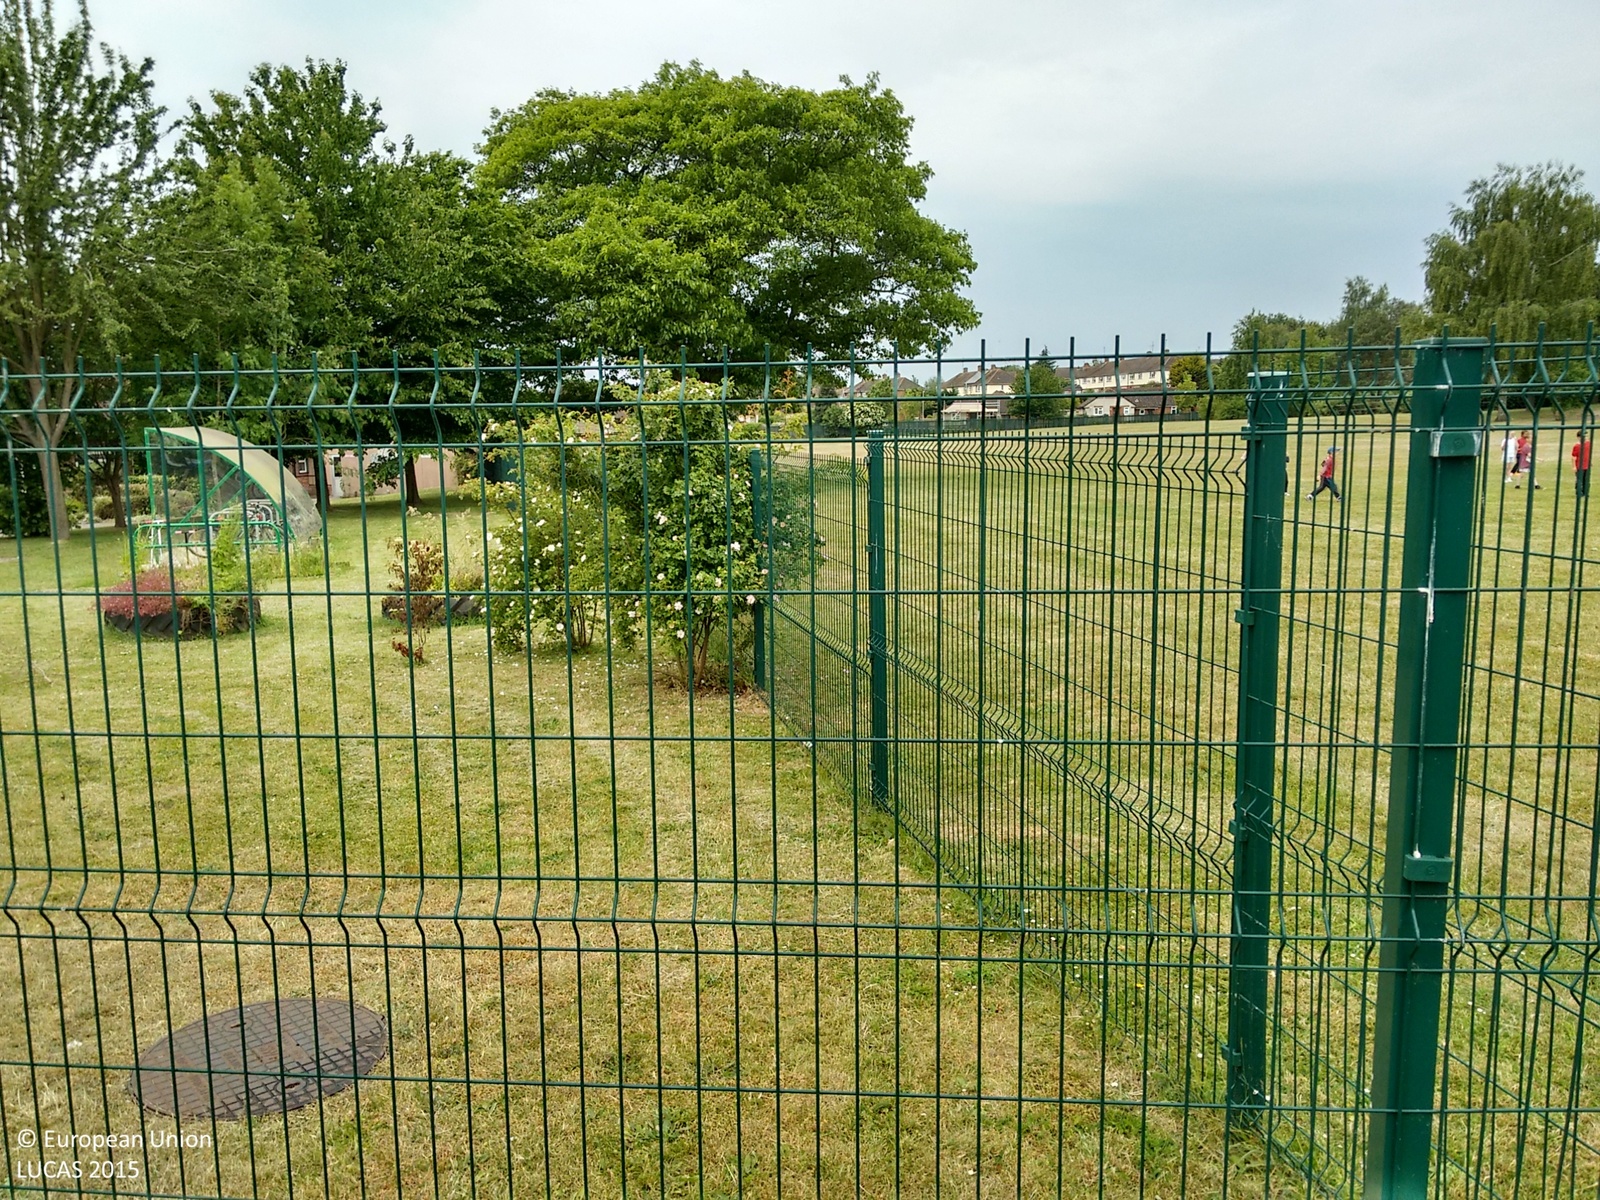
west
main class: Grassland
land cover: Grassland without tree/shrub cover
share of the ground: > 75 %
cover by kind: herbaceous plants 100 %
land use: Community services
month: June
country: GB
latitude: 51.4422
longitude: -1.0514
